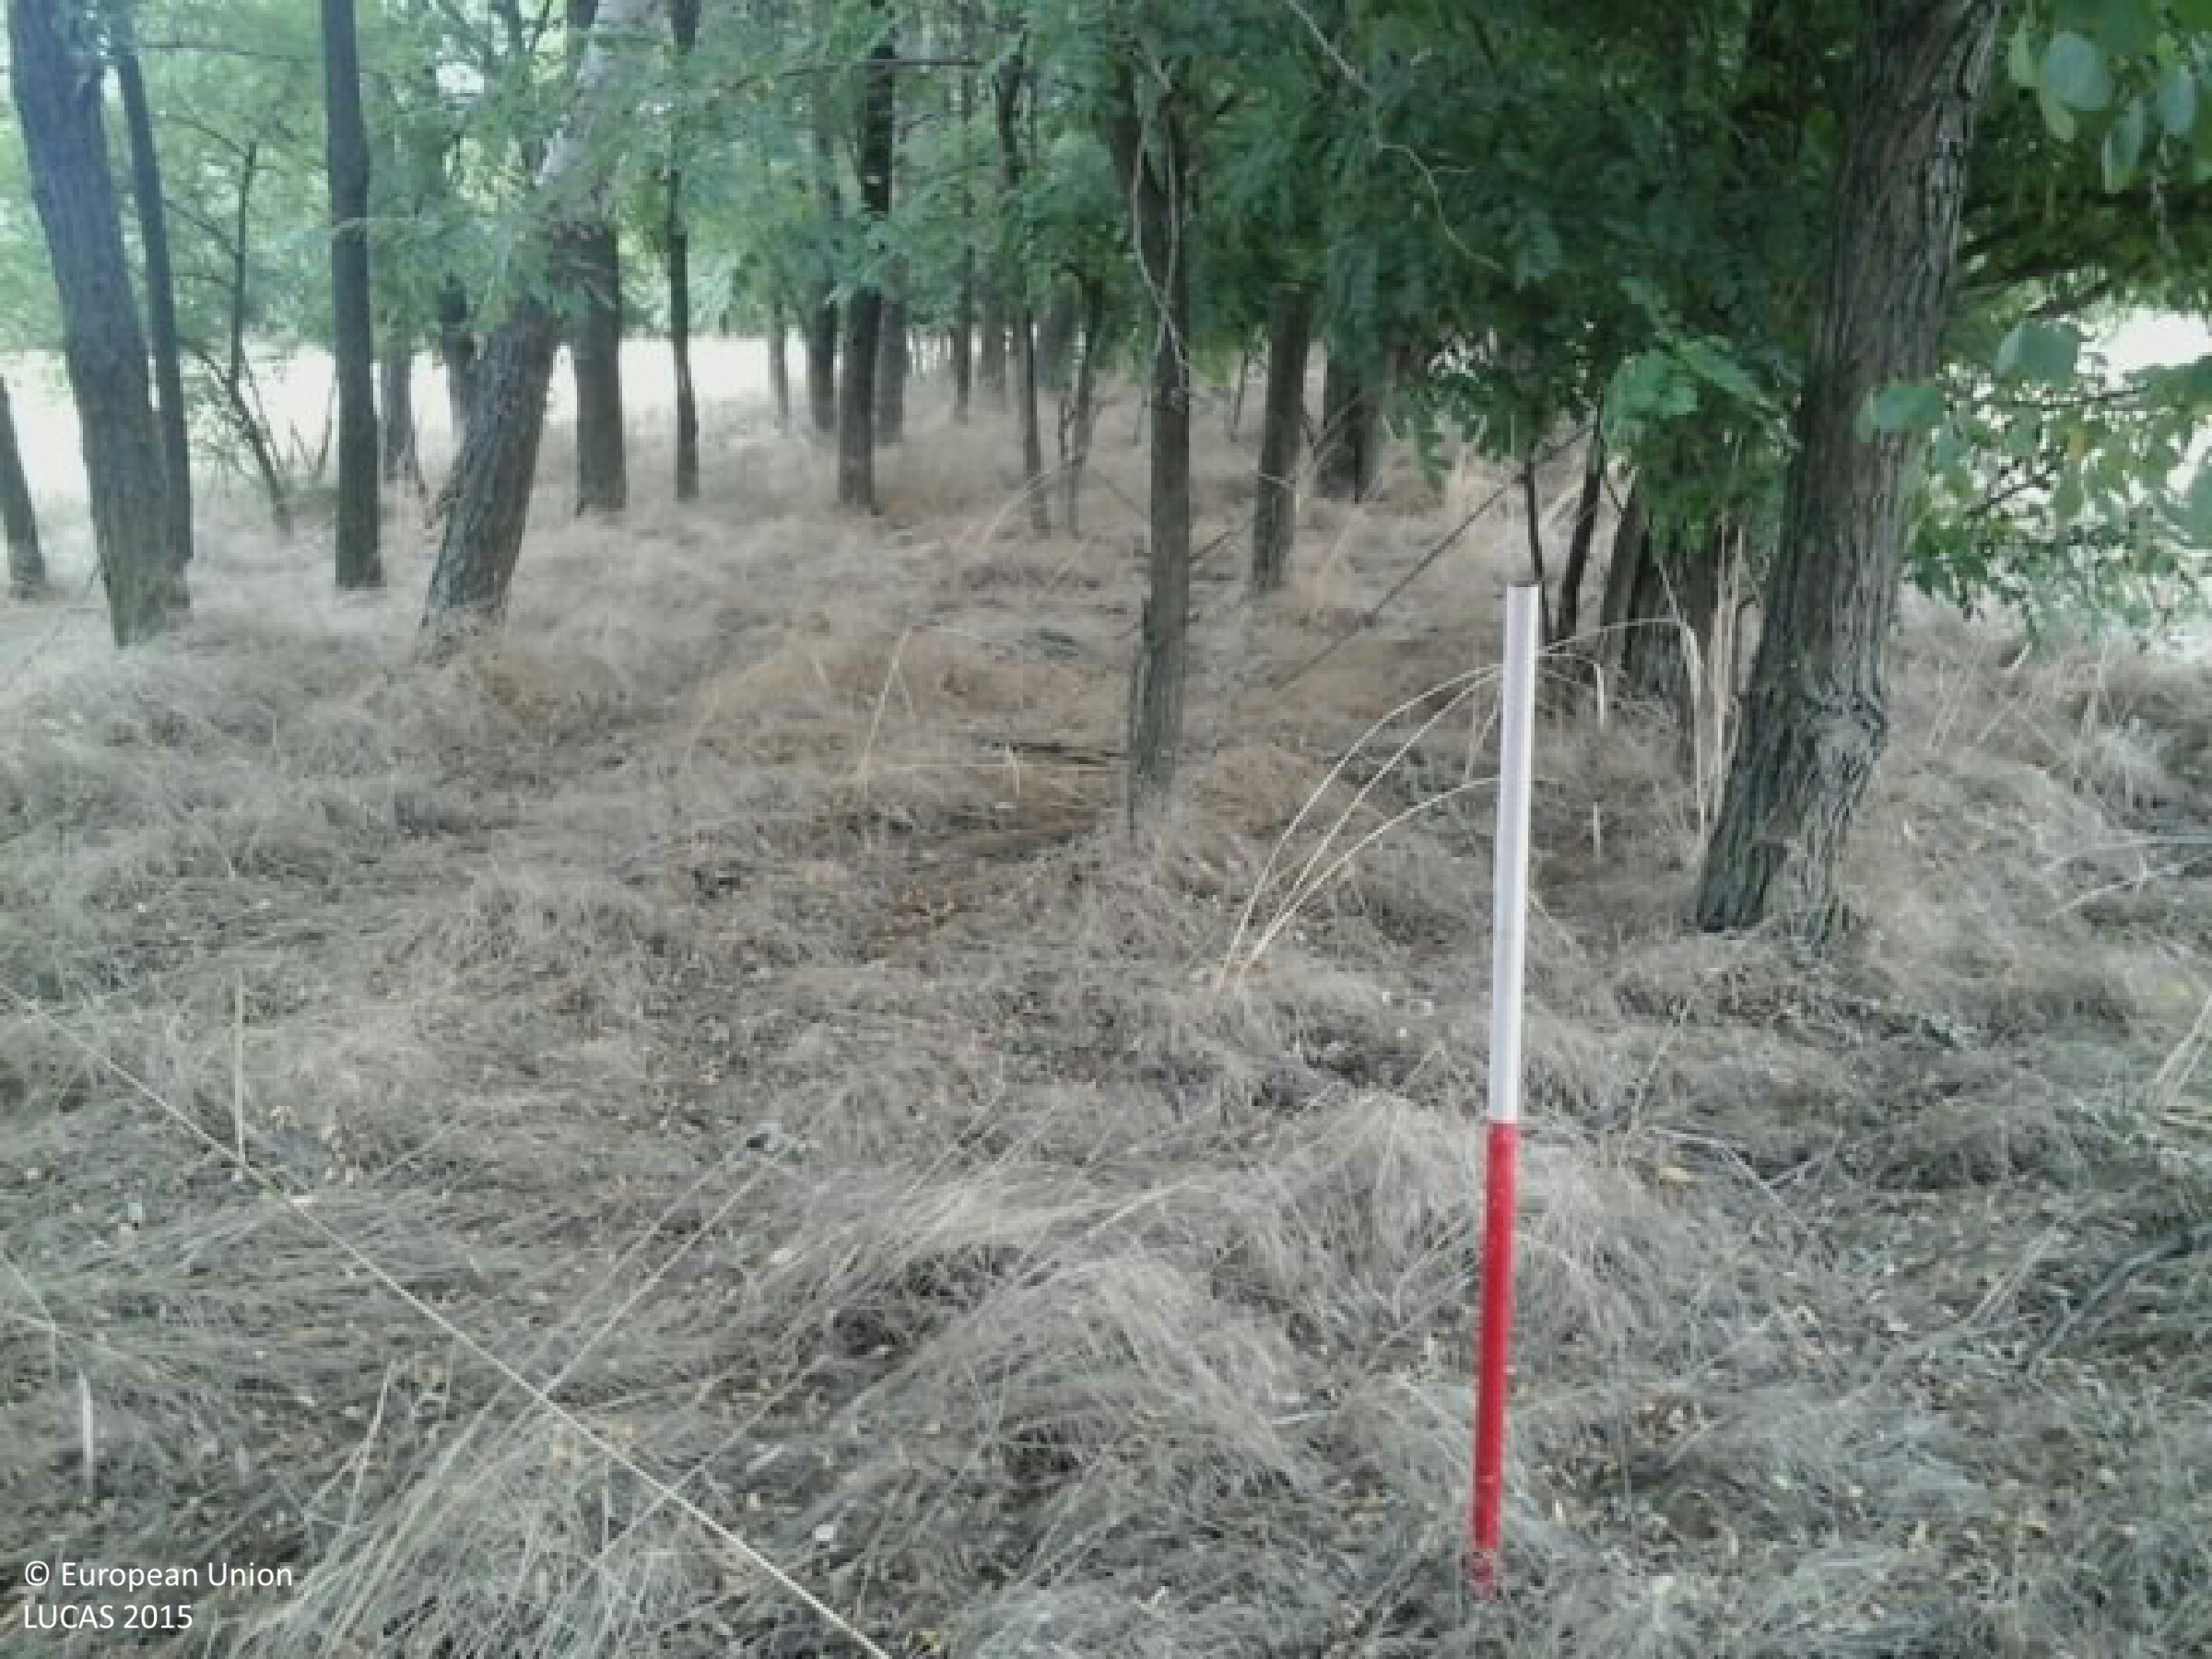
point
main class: Woodland
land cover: Broadleaved woodland
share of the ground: > 75 %
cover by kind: broadleaved forest trees 75 %, herbaceous plants 25 %
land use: Forestry
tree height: > 5 m
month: July
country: HU
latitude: 47.0200
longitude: 19.8502
